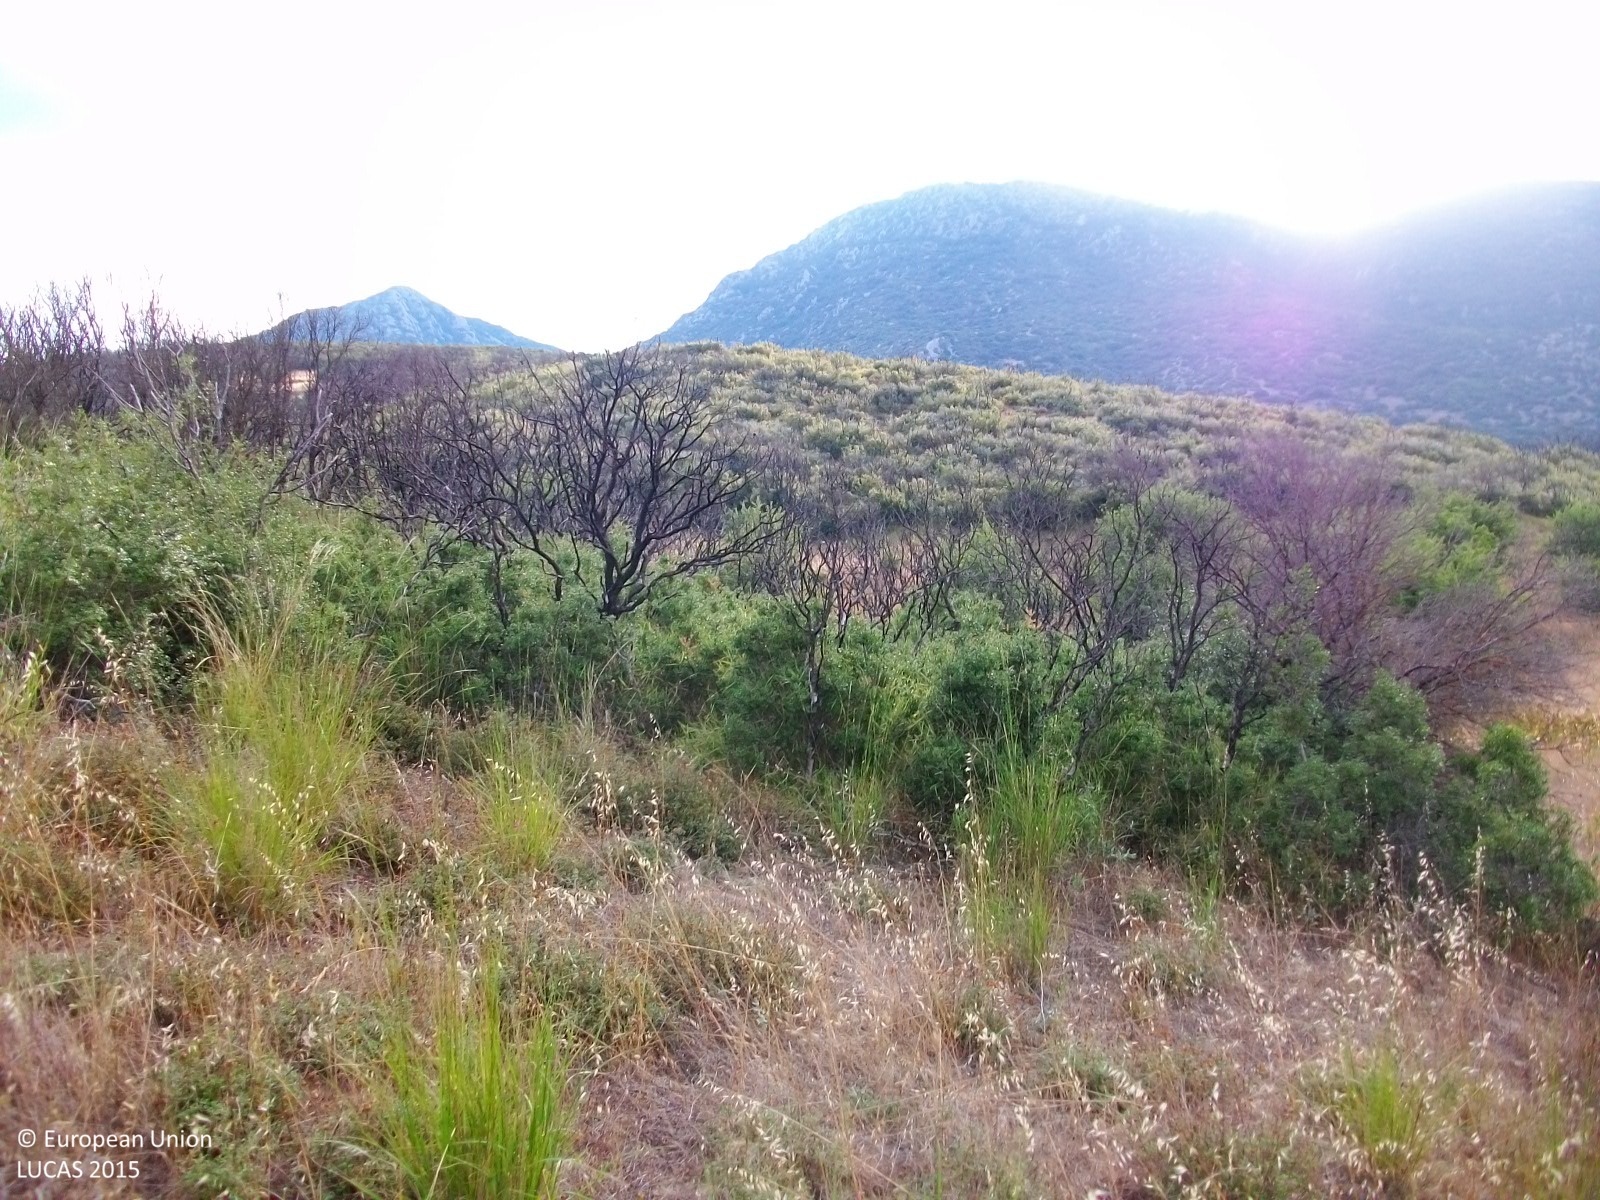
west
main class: Grassland
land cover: Grassland with sparse tree/shrub cover
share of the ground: > 75 %
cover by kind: herbaceous plants 85 %, shrubs 10 %, broadleaved forest trees 5 %
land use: Agriculture (excluding fallow land and kitchen gardens)
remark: Burnt area
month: July
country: GR
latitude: 38.4603
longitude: 22.2011
